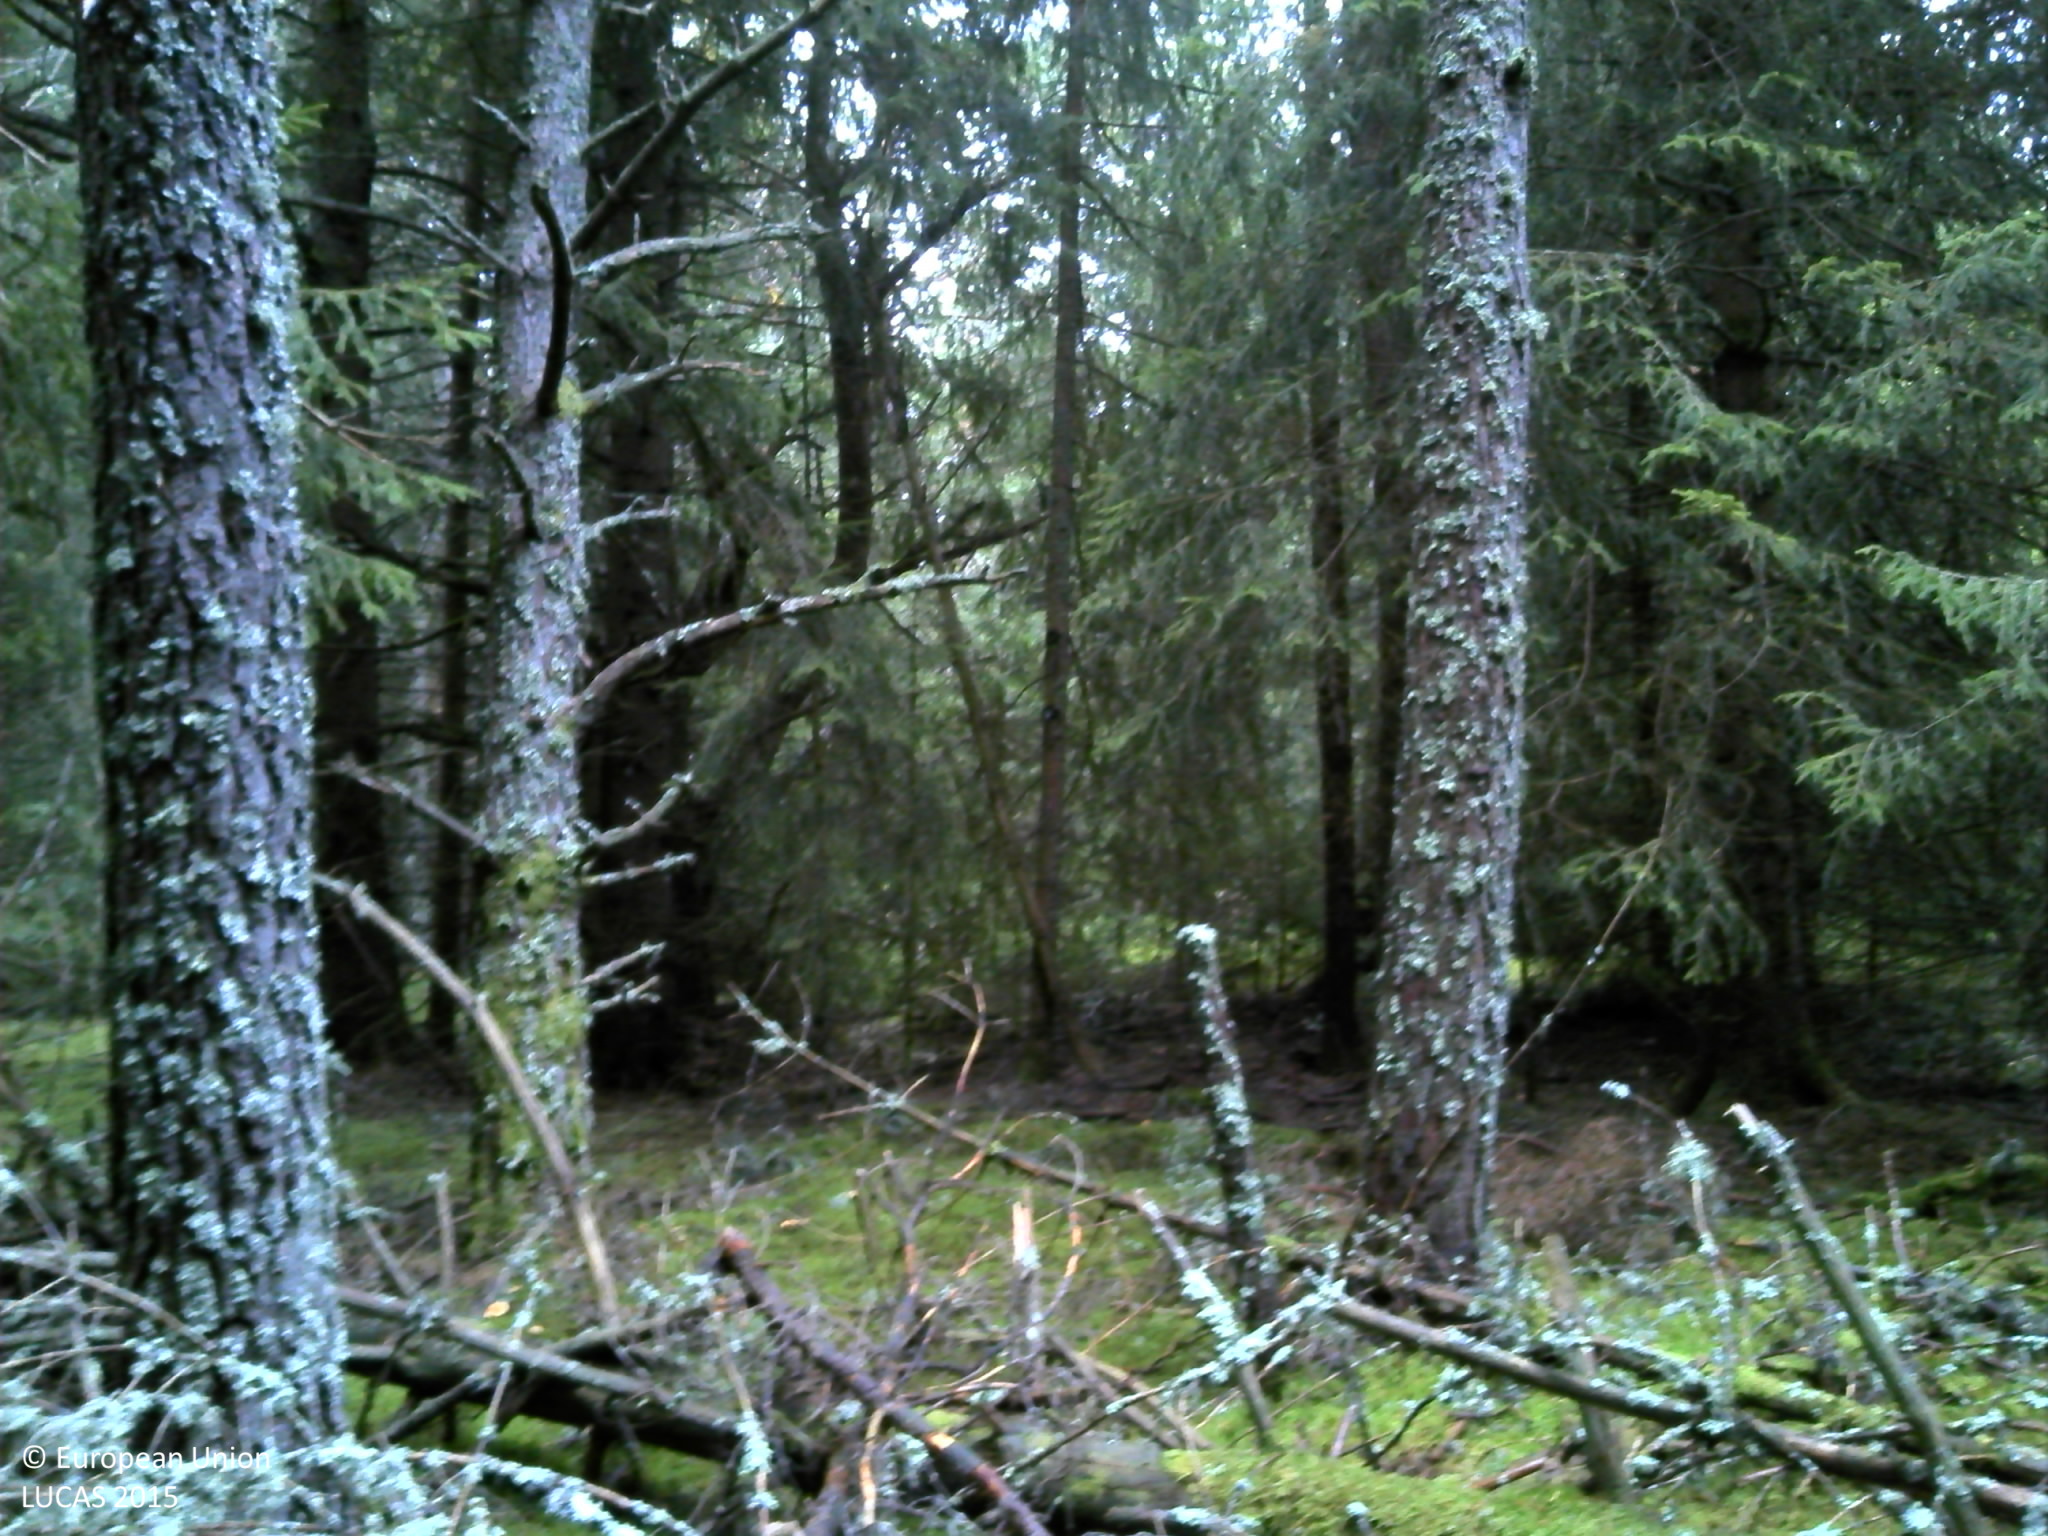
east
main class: Woodland
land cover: Spruce dominated coniferous woodland
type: alpine coniferous forest
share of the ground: > 75 %
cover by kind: coniferous forest trees 75 %, lichens and mosses 25 %
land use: Forestry
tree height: > 5 m
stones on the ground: < 10 %
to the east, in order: Spruce dominated coniferous woodland; Shrubland with sparse tree cover; Ditches and canals; Shrubland without tree cover; Abandoned hedges
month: September
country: FR
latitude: 45.6436
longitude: 2.8786
